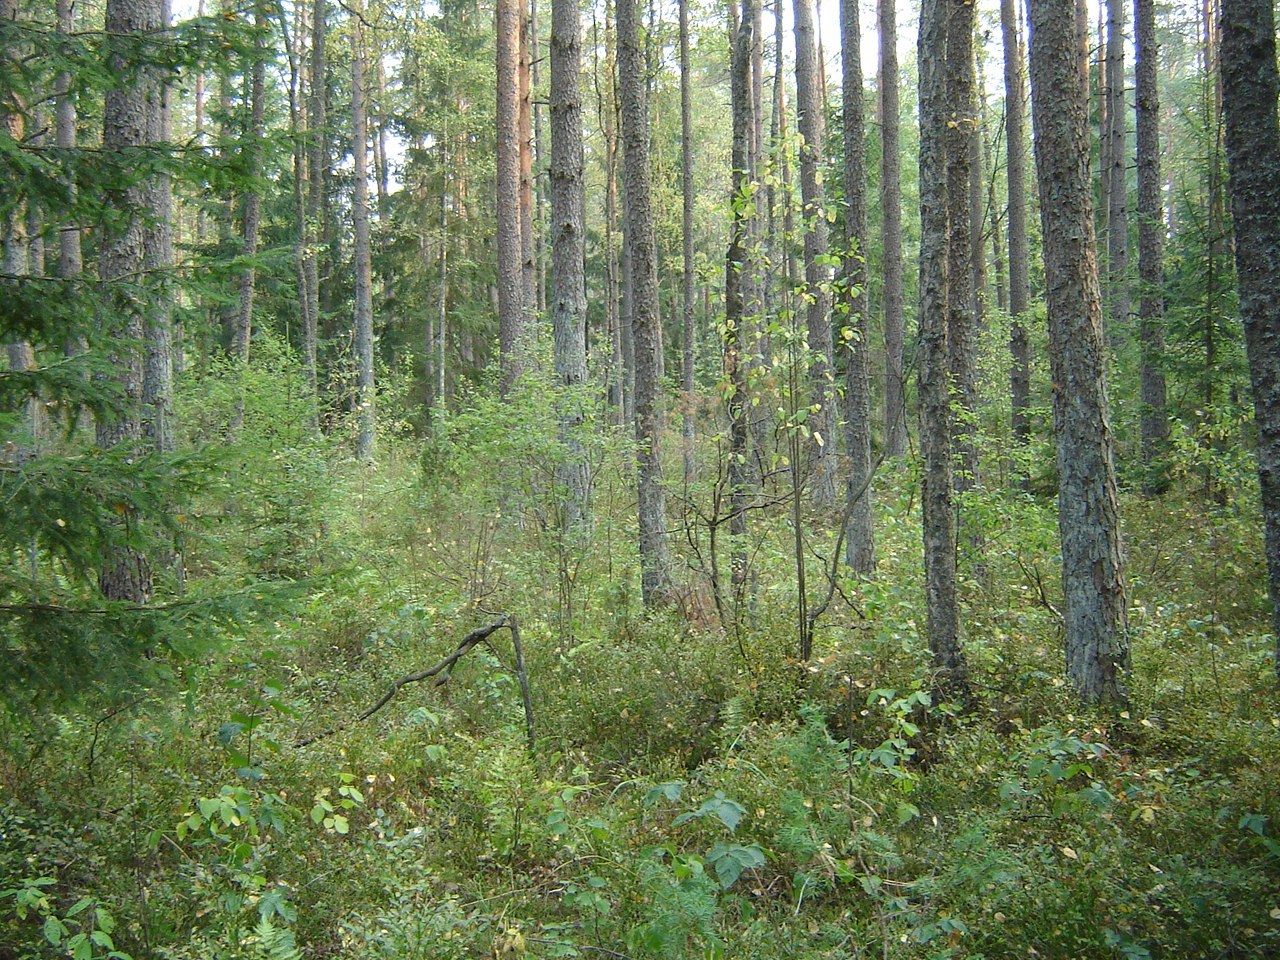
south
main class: Woodland
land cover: Pine dominated coniferous woodland
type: hemiboreal forest and nemoral coniferous forest and mixed broadleaved-coniferous forest
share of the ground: > 75 %
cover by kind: coniferous forest trees 60 %, broadleaved forest trees 20 %, shrubs 10 %, lichens and mosses 10 %
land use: Forestry
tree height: > 5 m
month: September
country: LT
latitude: 54.4781
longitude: 24.8182
